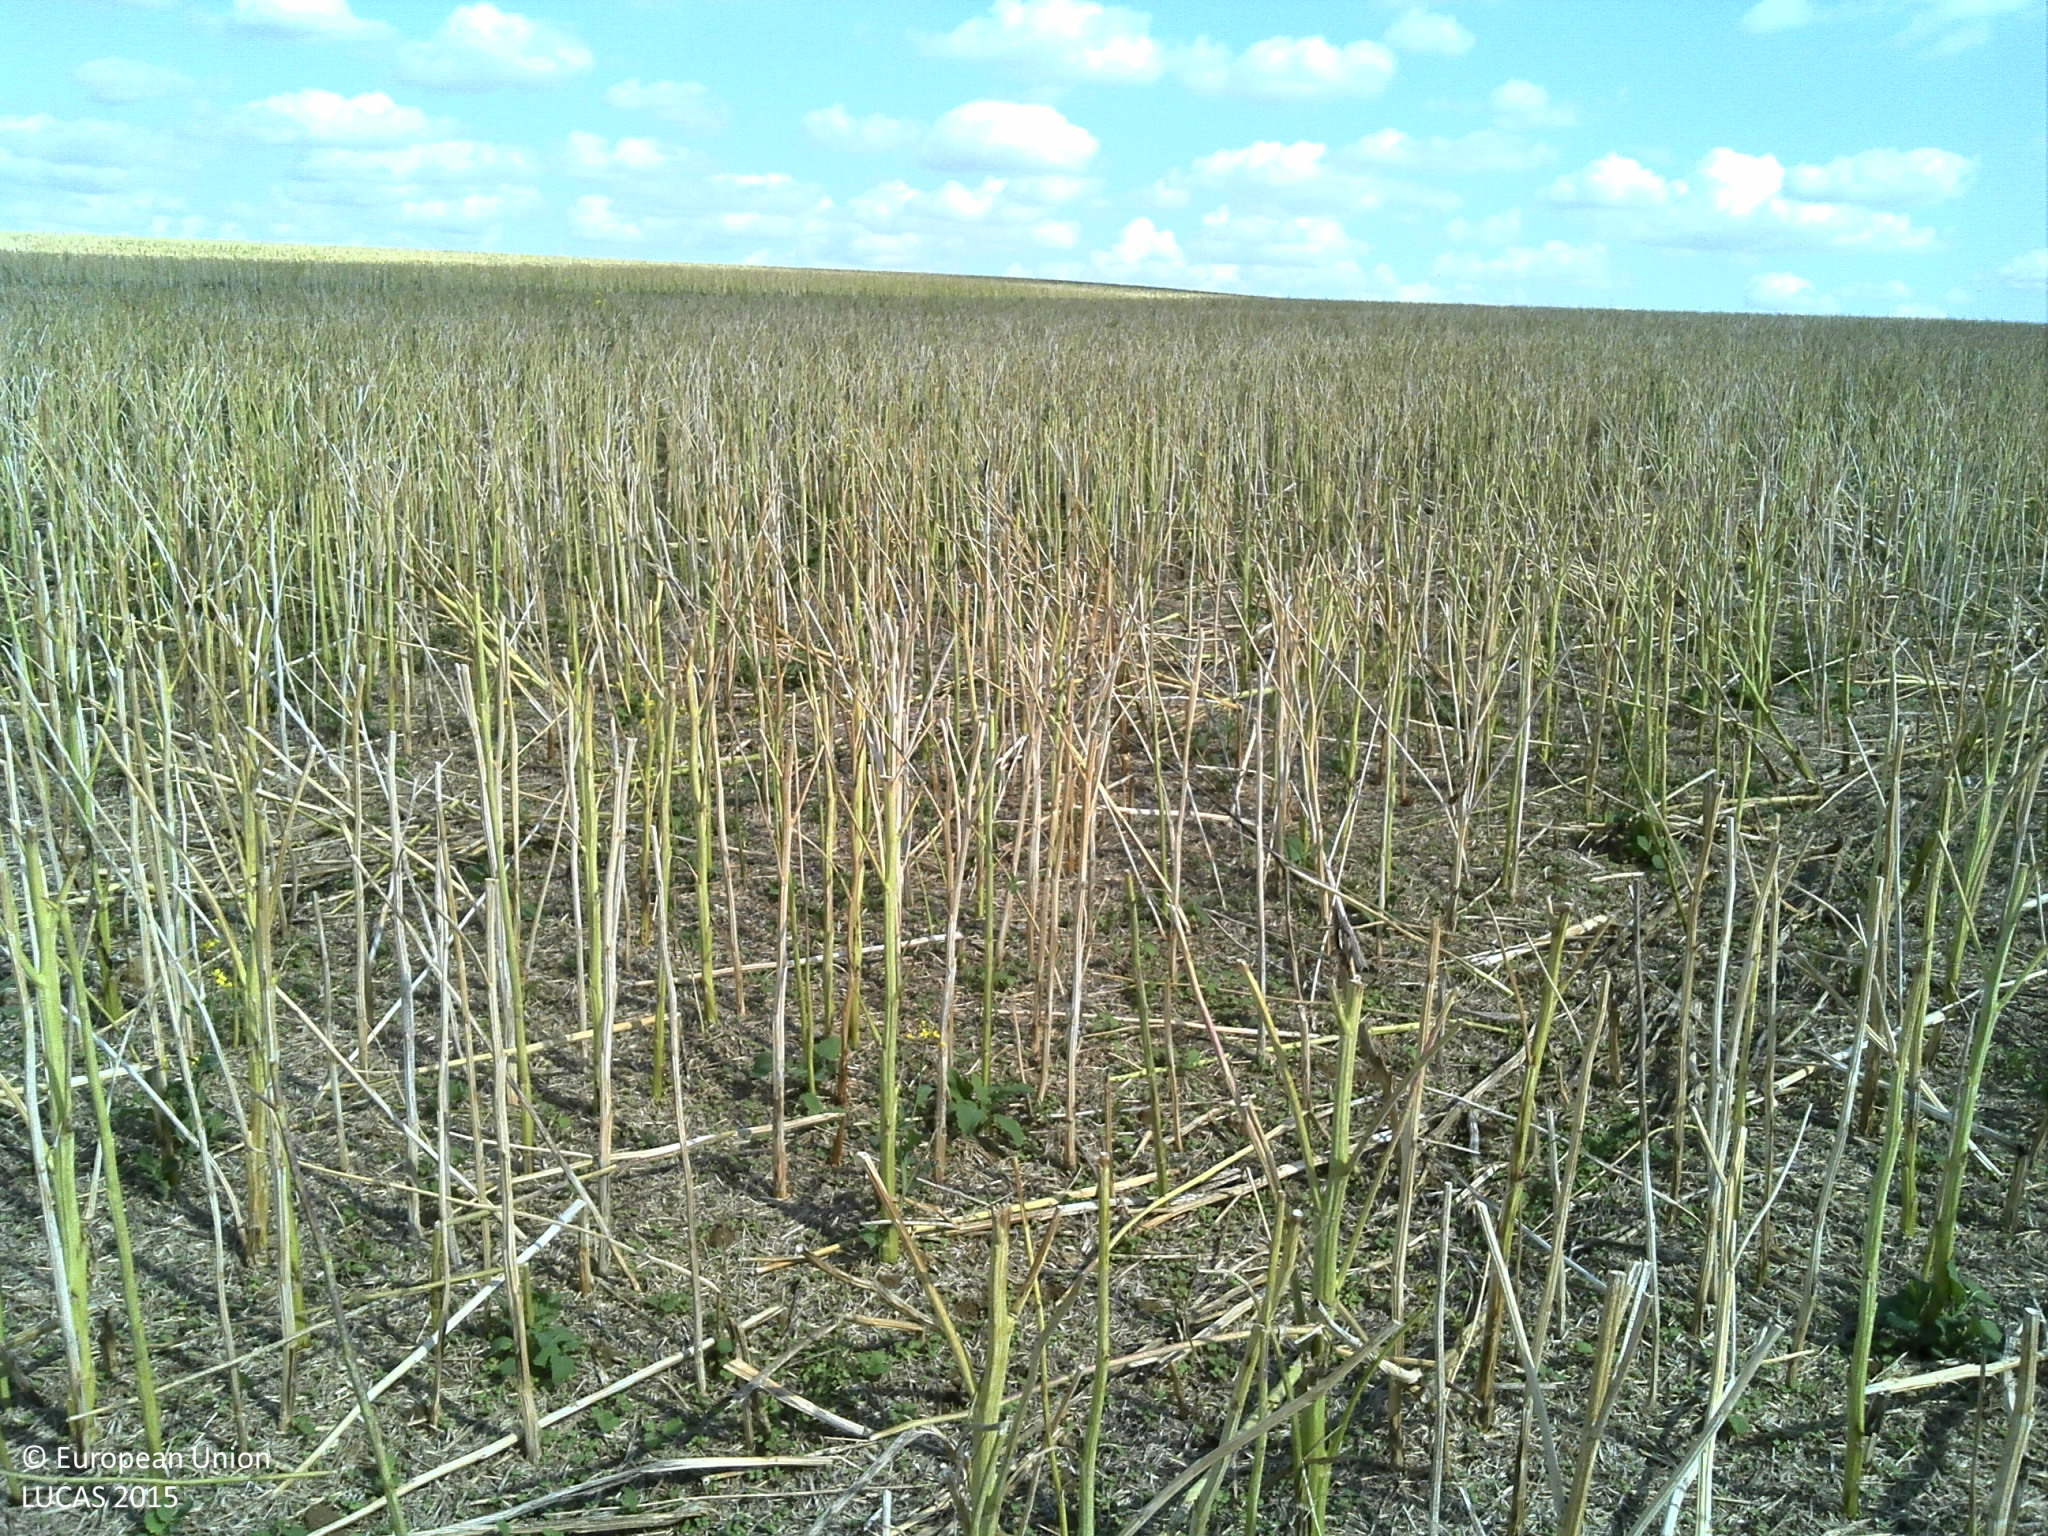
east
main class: Cropland
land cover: Rape and turnip rape
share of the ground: 10 - 25 %
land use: Agriculture (excluding fallow land and kitchen gardens)
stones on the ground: < 10 %
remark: Harvested field
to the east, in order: Rape and turnip rape
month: August
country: FR
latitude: 49.9420
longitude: 3.1492
